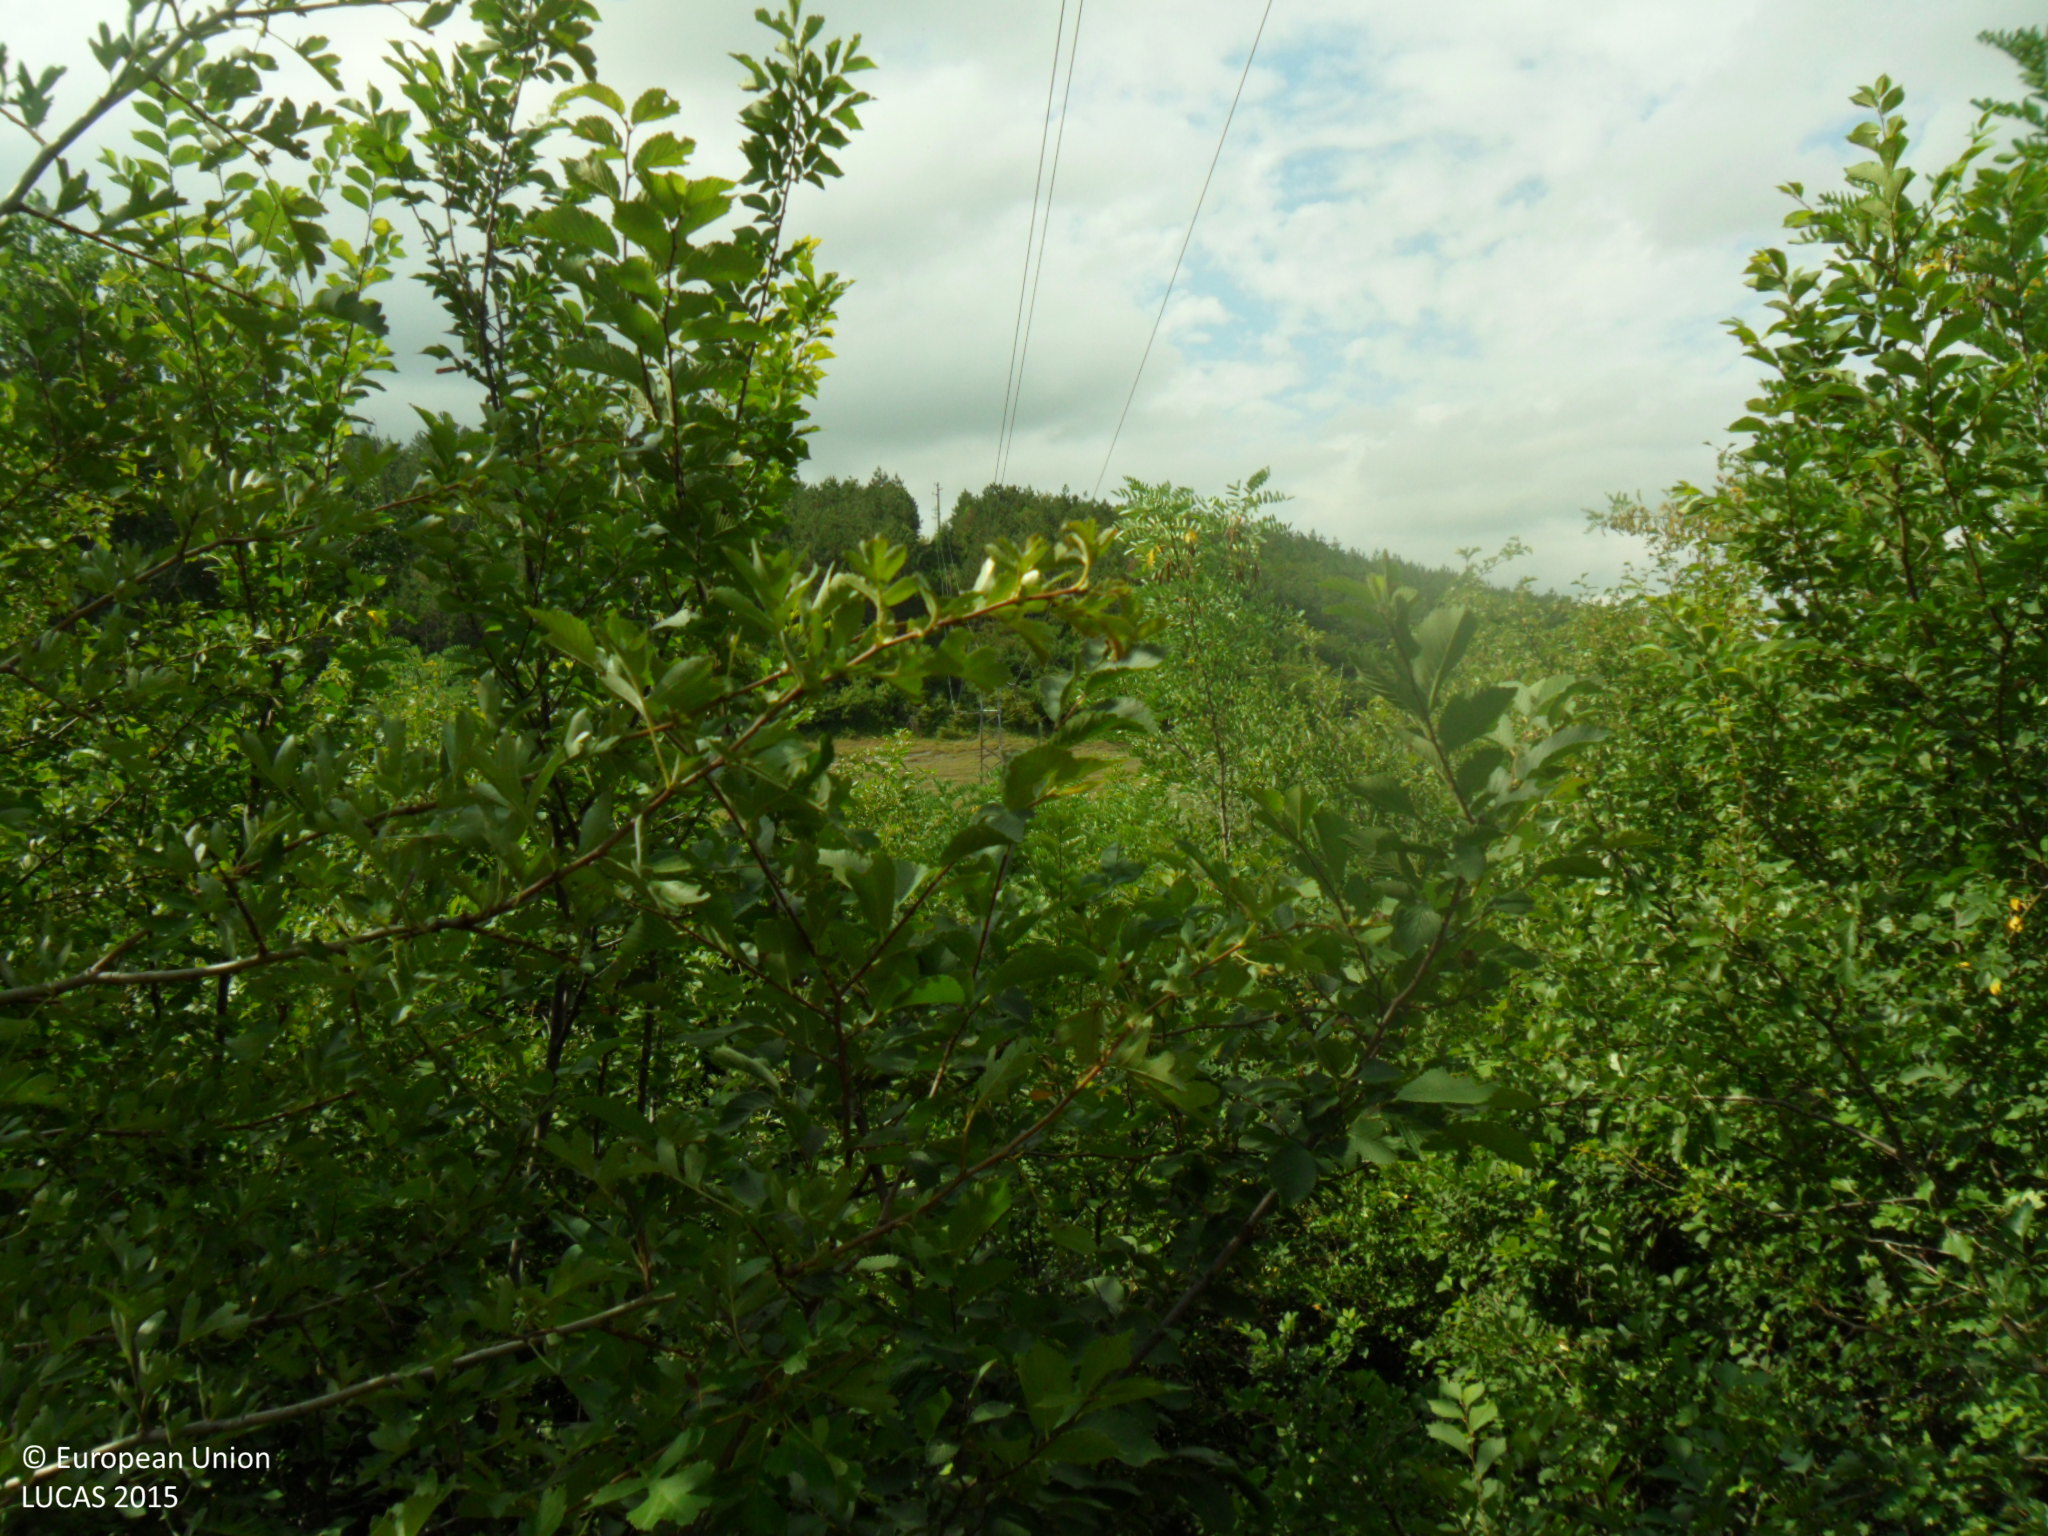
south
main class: Shrubland
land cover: Shrubland with sparse tree cover
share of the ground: > 75 %
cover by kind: shrubs 90 %, broadleaved forest trees 5 %, herbaceous plants 5 %
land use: Semi-natural and natural areas not in use
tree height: < 5 m
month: July
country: BG
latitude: 43.3812
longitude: 27.1919
